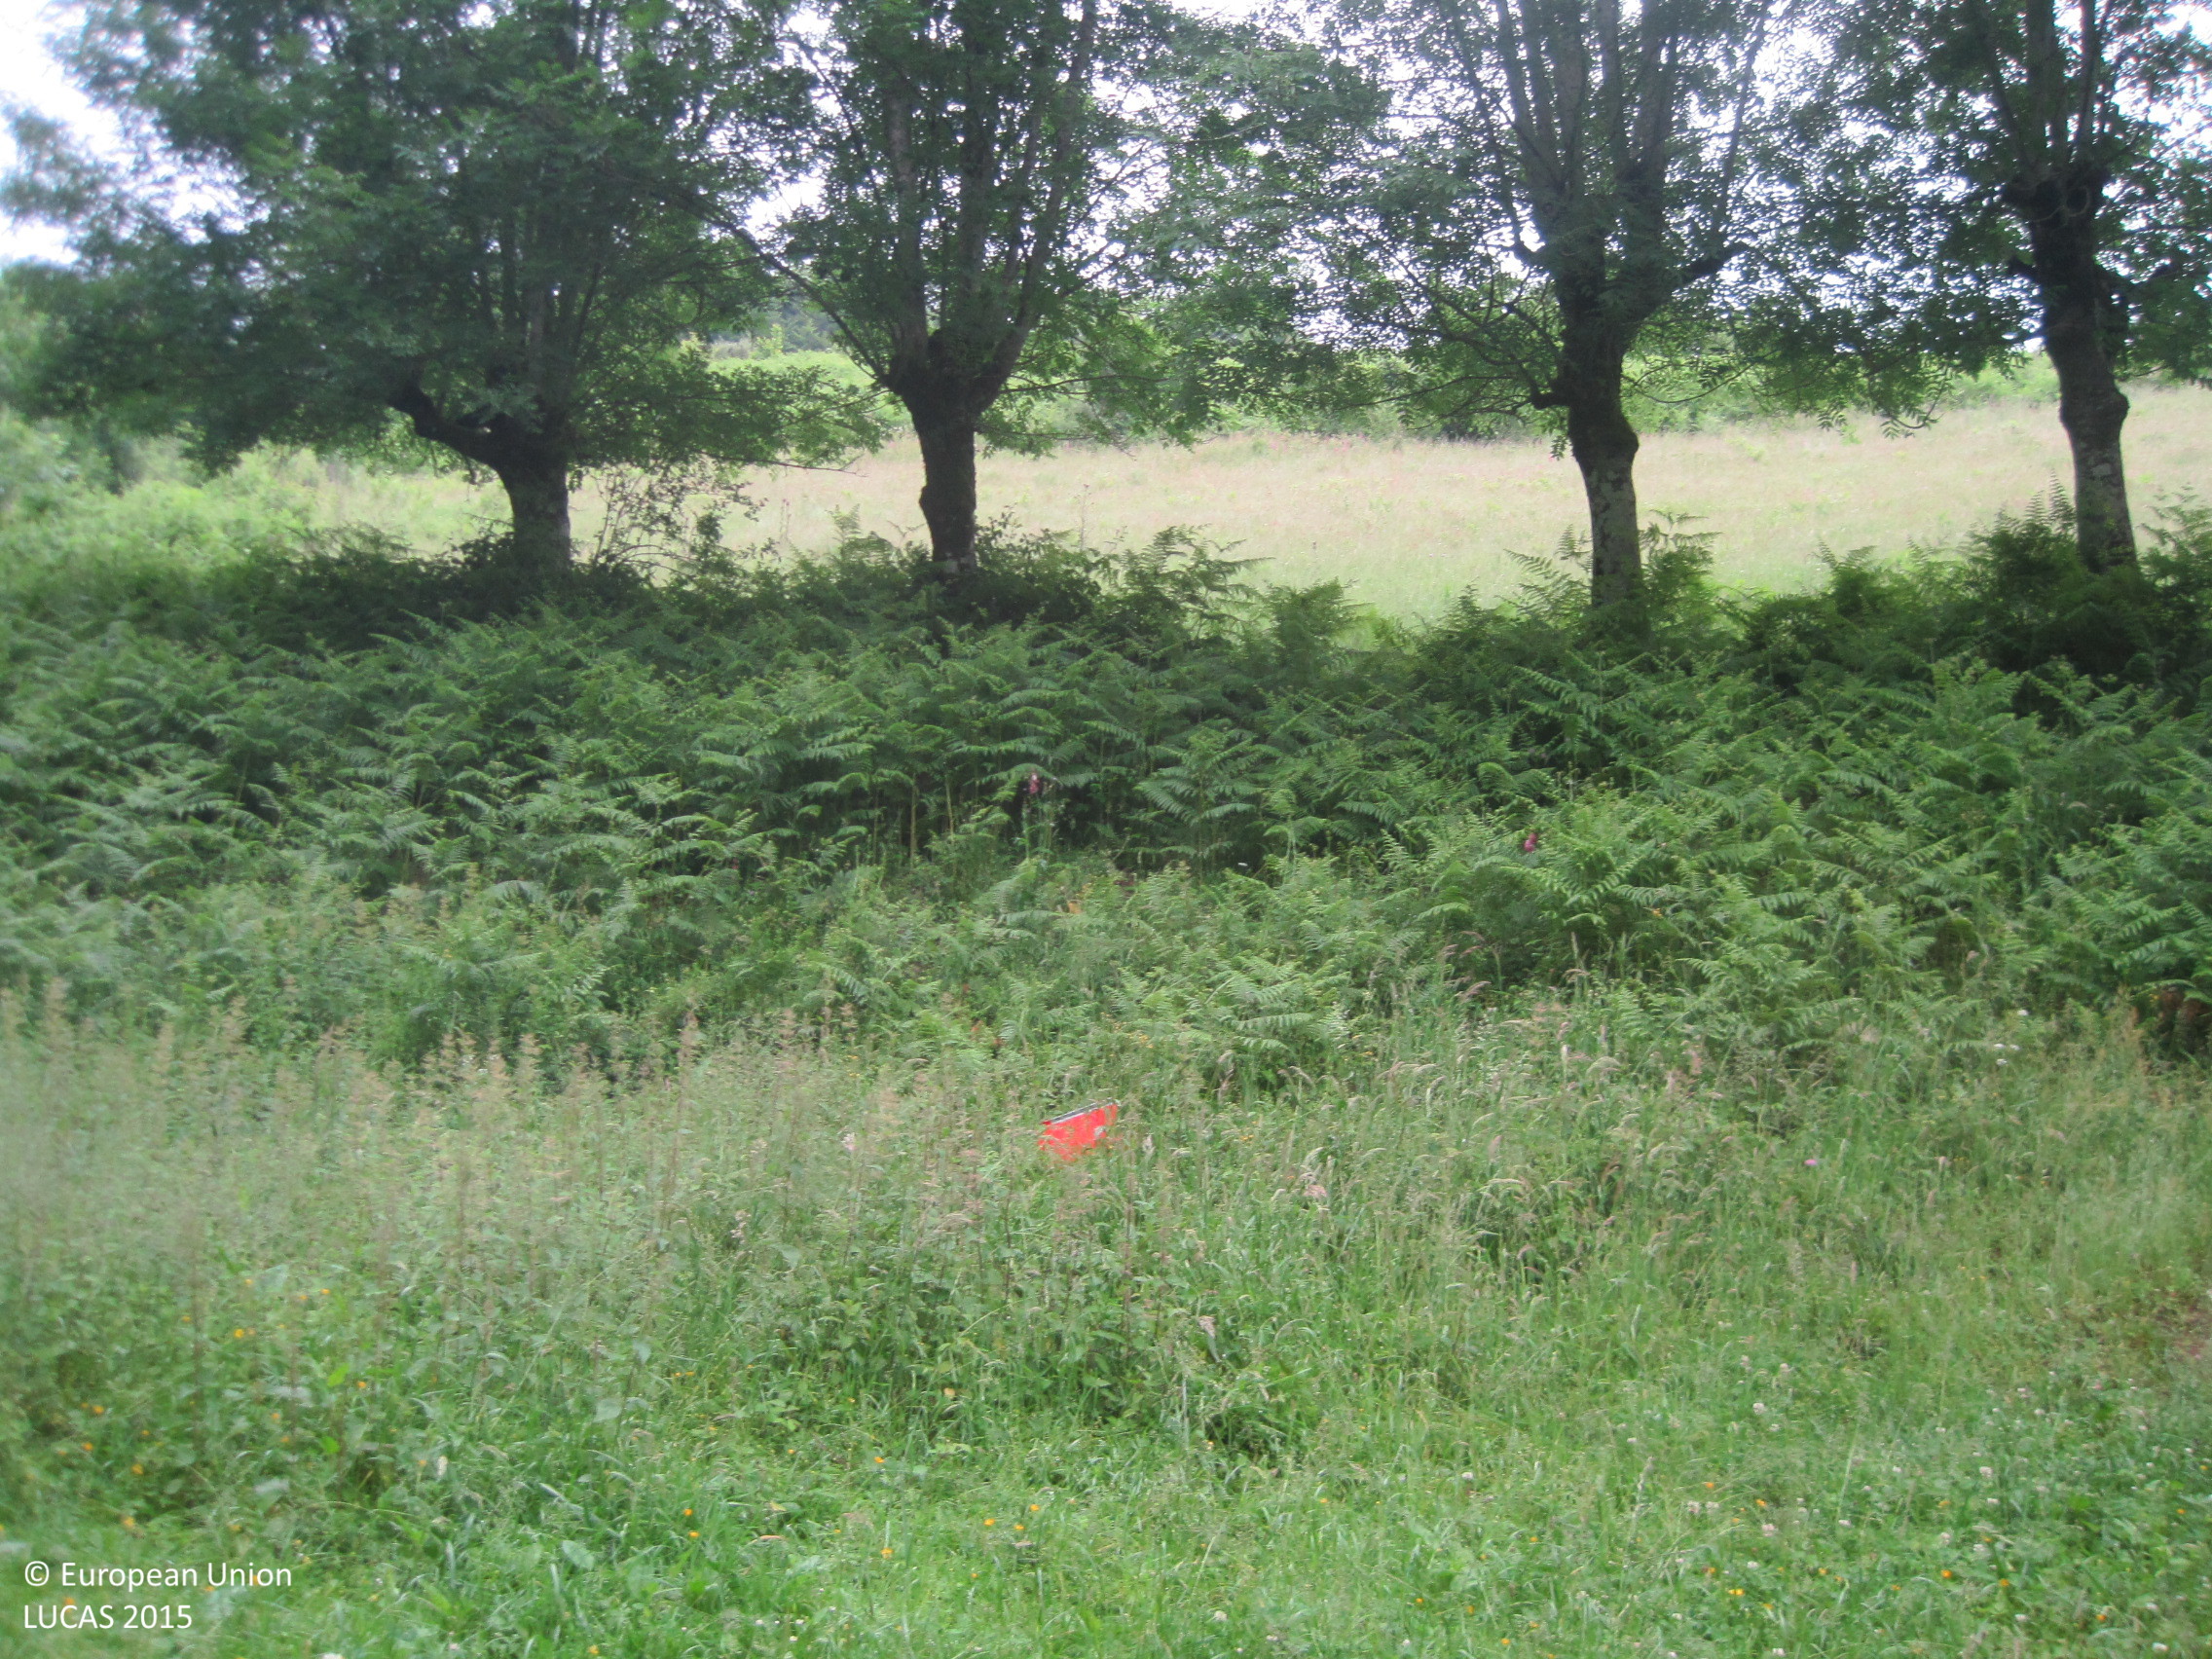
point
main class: Woodland
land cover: Broadleaved woodland
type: beech forest
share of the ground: 50 - 75 %
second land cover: Grassland without tree/shrub cover
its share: > 75 %
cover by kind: herbaceous plants 60 %, broadleaved forest trees 40 %
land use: Forestry
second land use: Agriculture (excluding fallow land and kitchen gardens)
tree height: > 5 m
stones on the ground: < 10 %
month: June
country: ES
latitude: 43.0356
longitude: -1.8134
